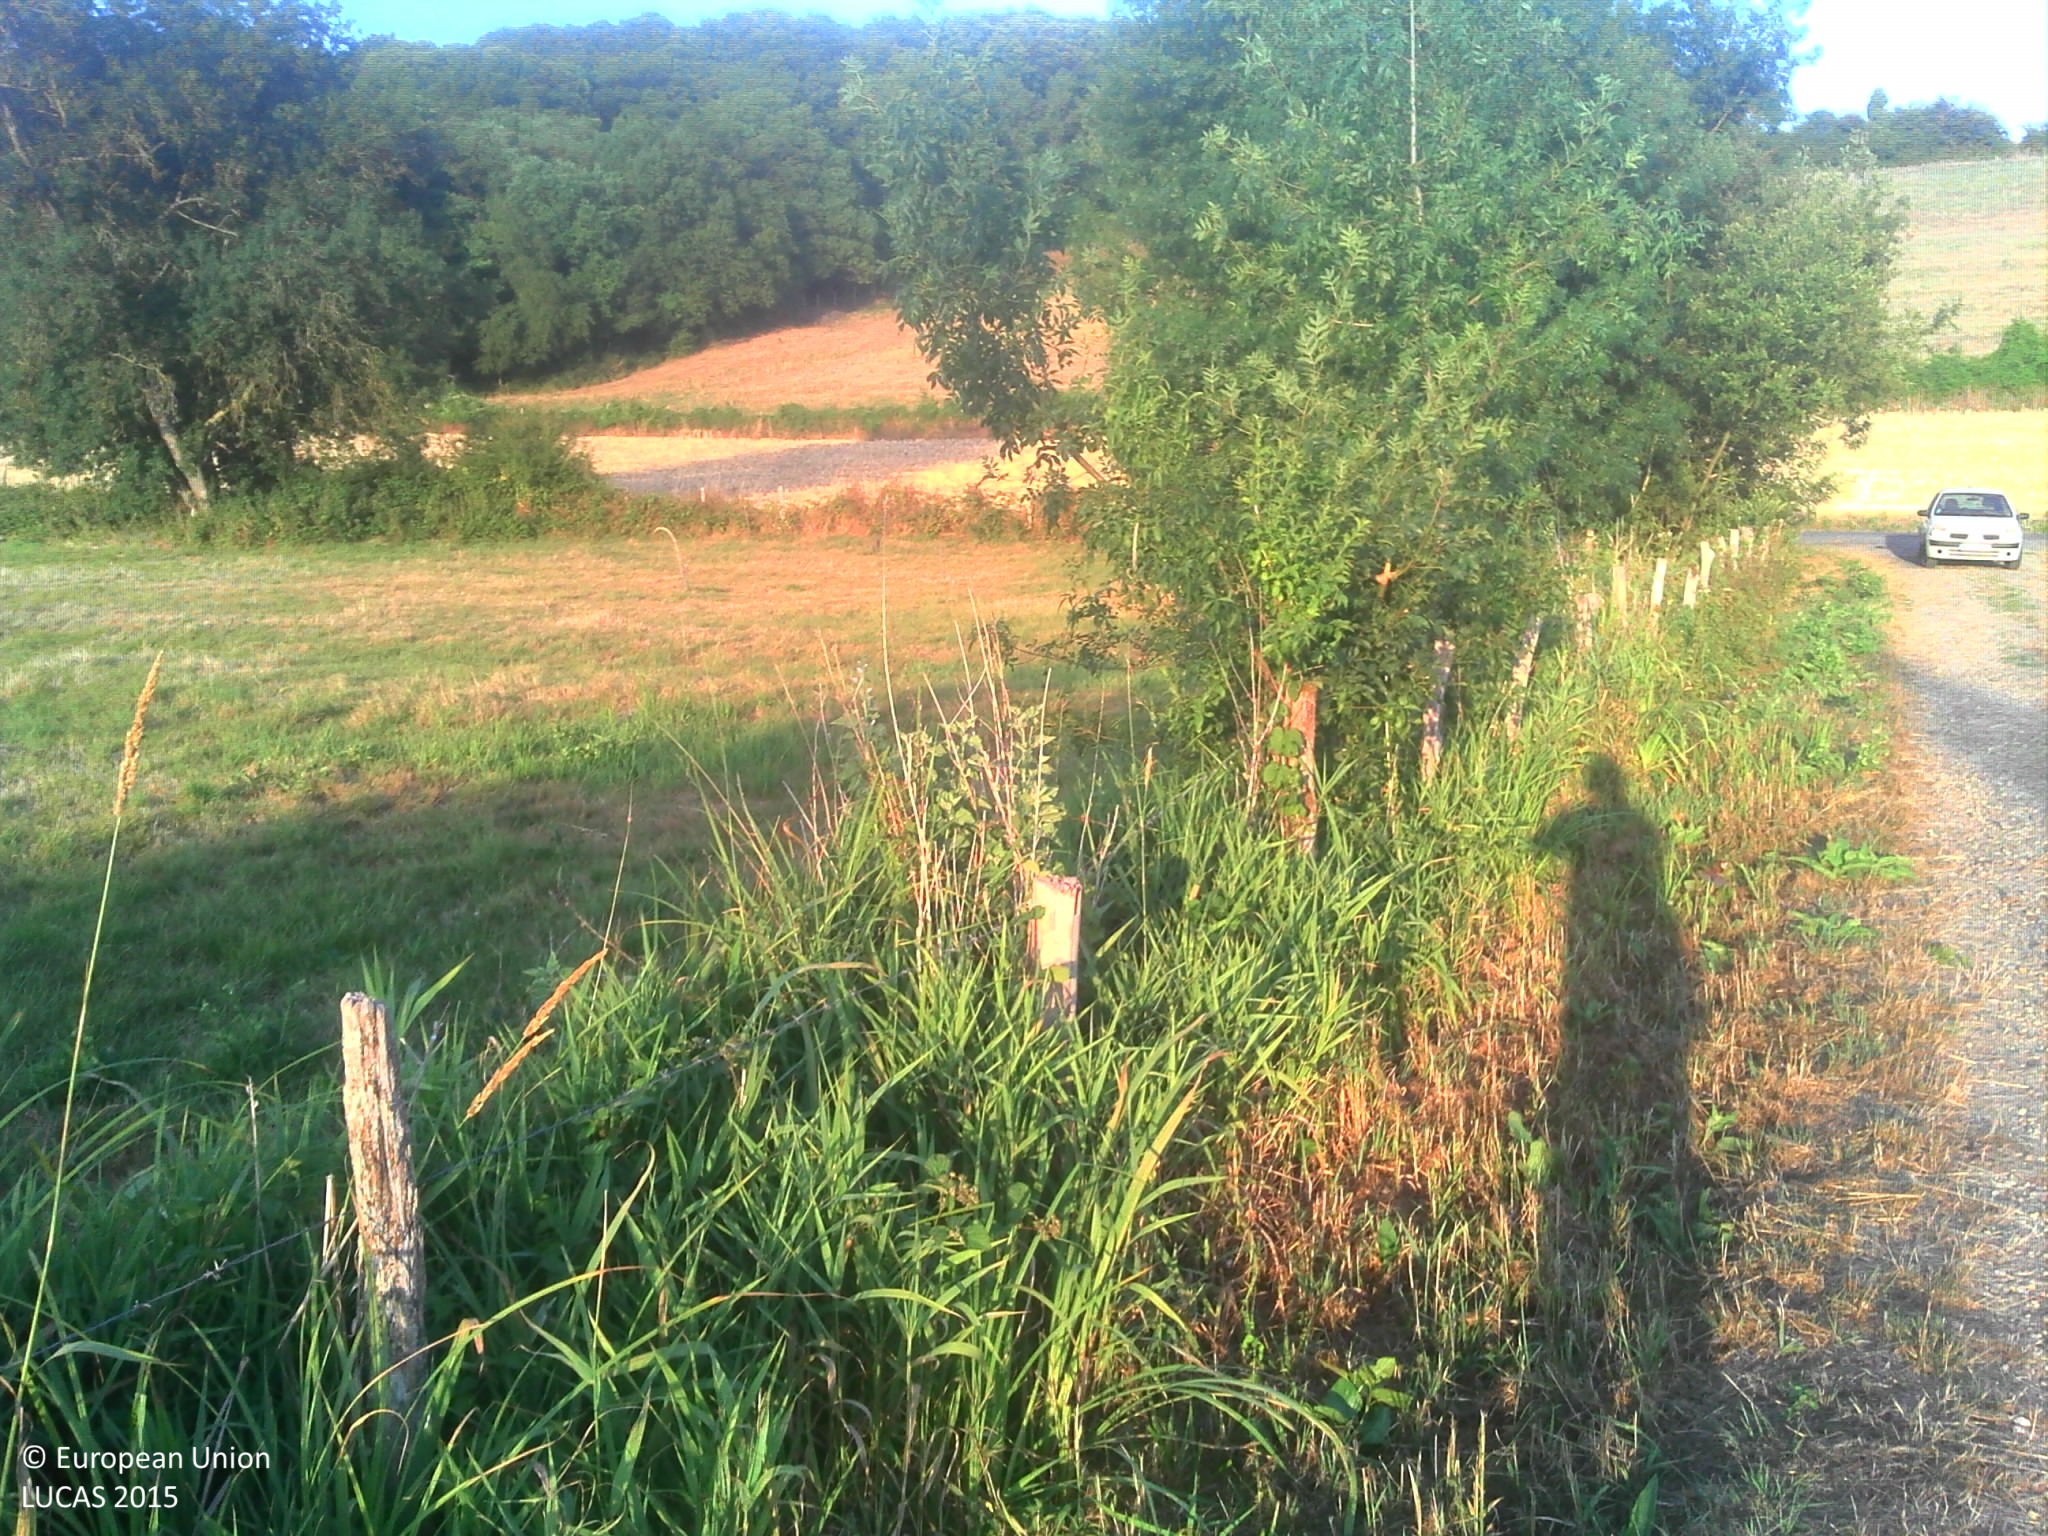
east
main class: Grassland
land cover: Grassland without tree/shrub cover
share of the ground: > 75 %
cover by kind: herbaceous plants 100 %
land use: Agriculture (excluding fallow land and kitchen gardens)
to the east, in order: Grassland without tree/shrub cover; Fences; Managed hedges; Fences; Ditches and canals; Paved roads, cycling and walking lanes; Grass margins; Barley; Fences; Grassland without tree/shrub cover; Fences; Broadleaved woodland
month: July
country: FR
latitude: 47.7958
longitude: 0.7277
